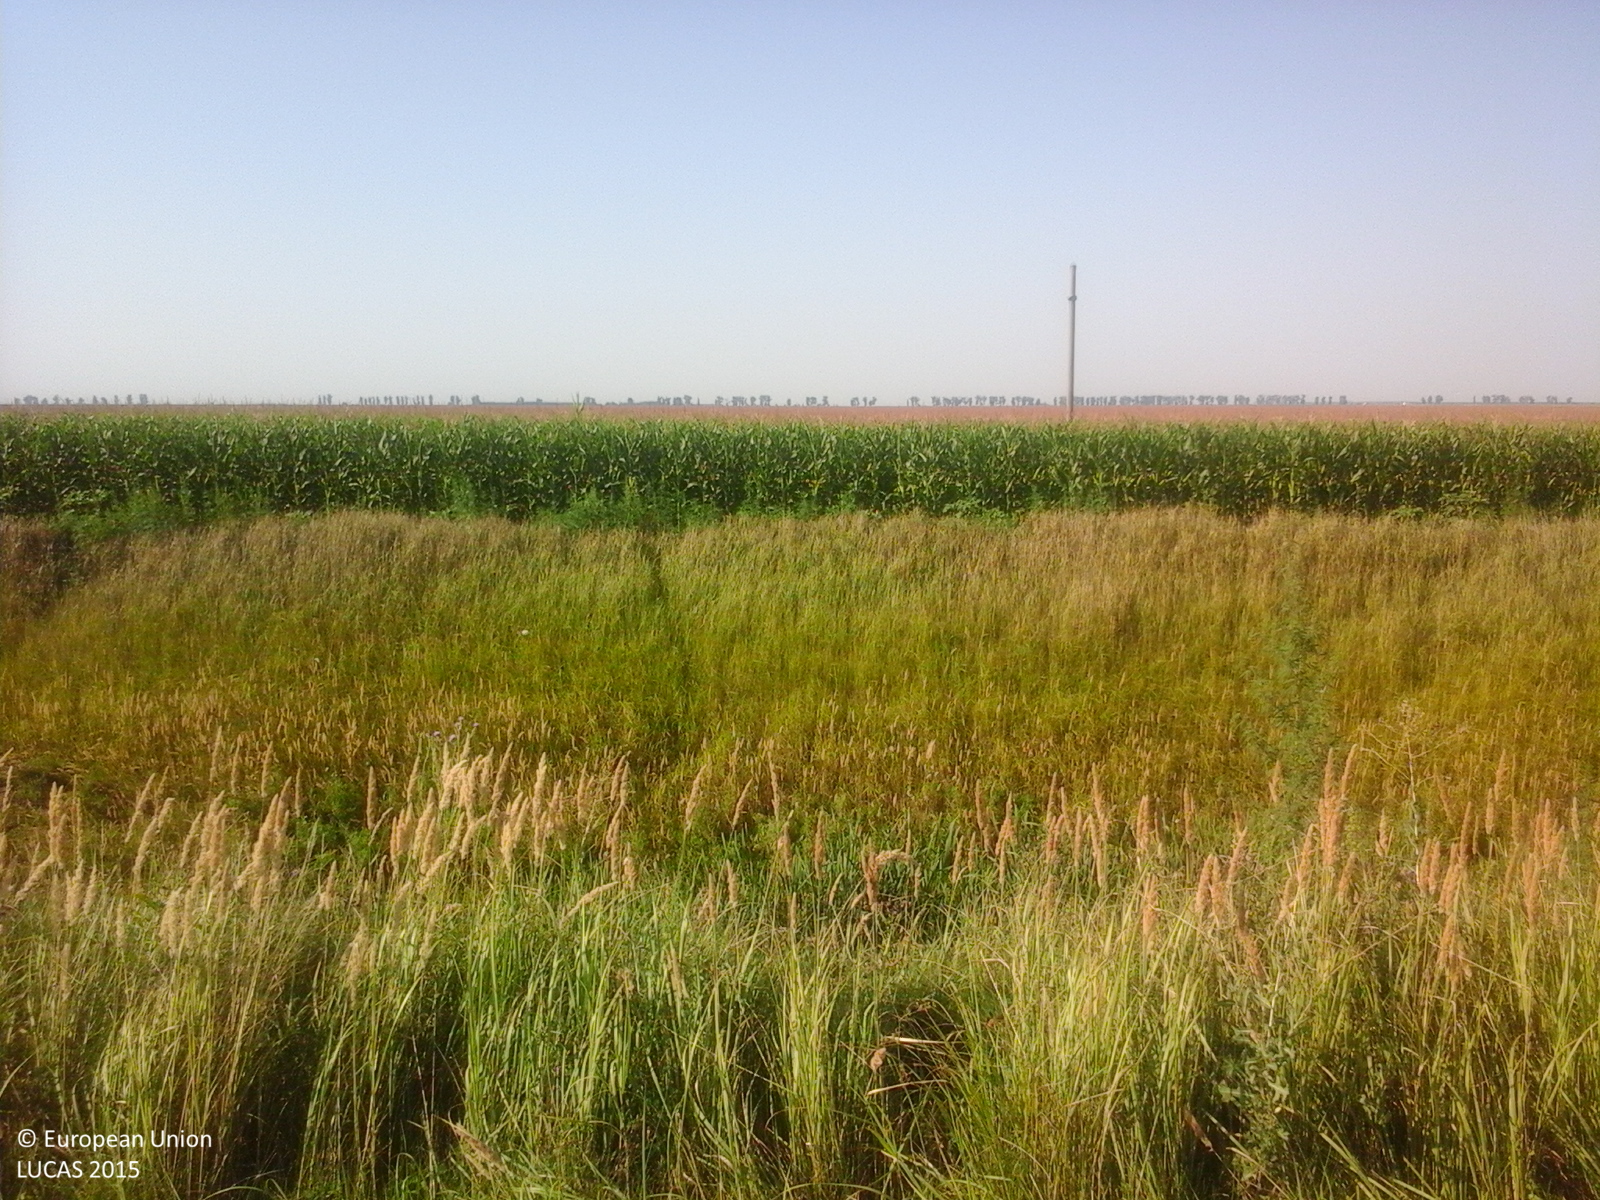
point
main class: Cropland
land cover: Maize
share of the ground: > 75 %
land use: Agriculture (excluding fallow land and kitchen gardens)
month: July
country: RO
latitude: 44.4591
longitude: 27.2404
